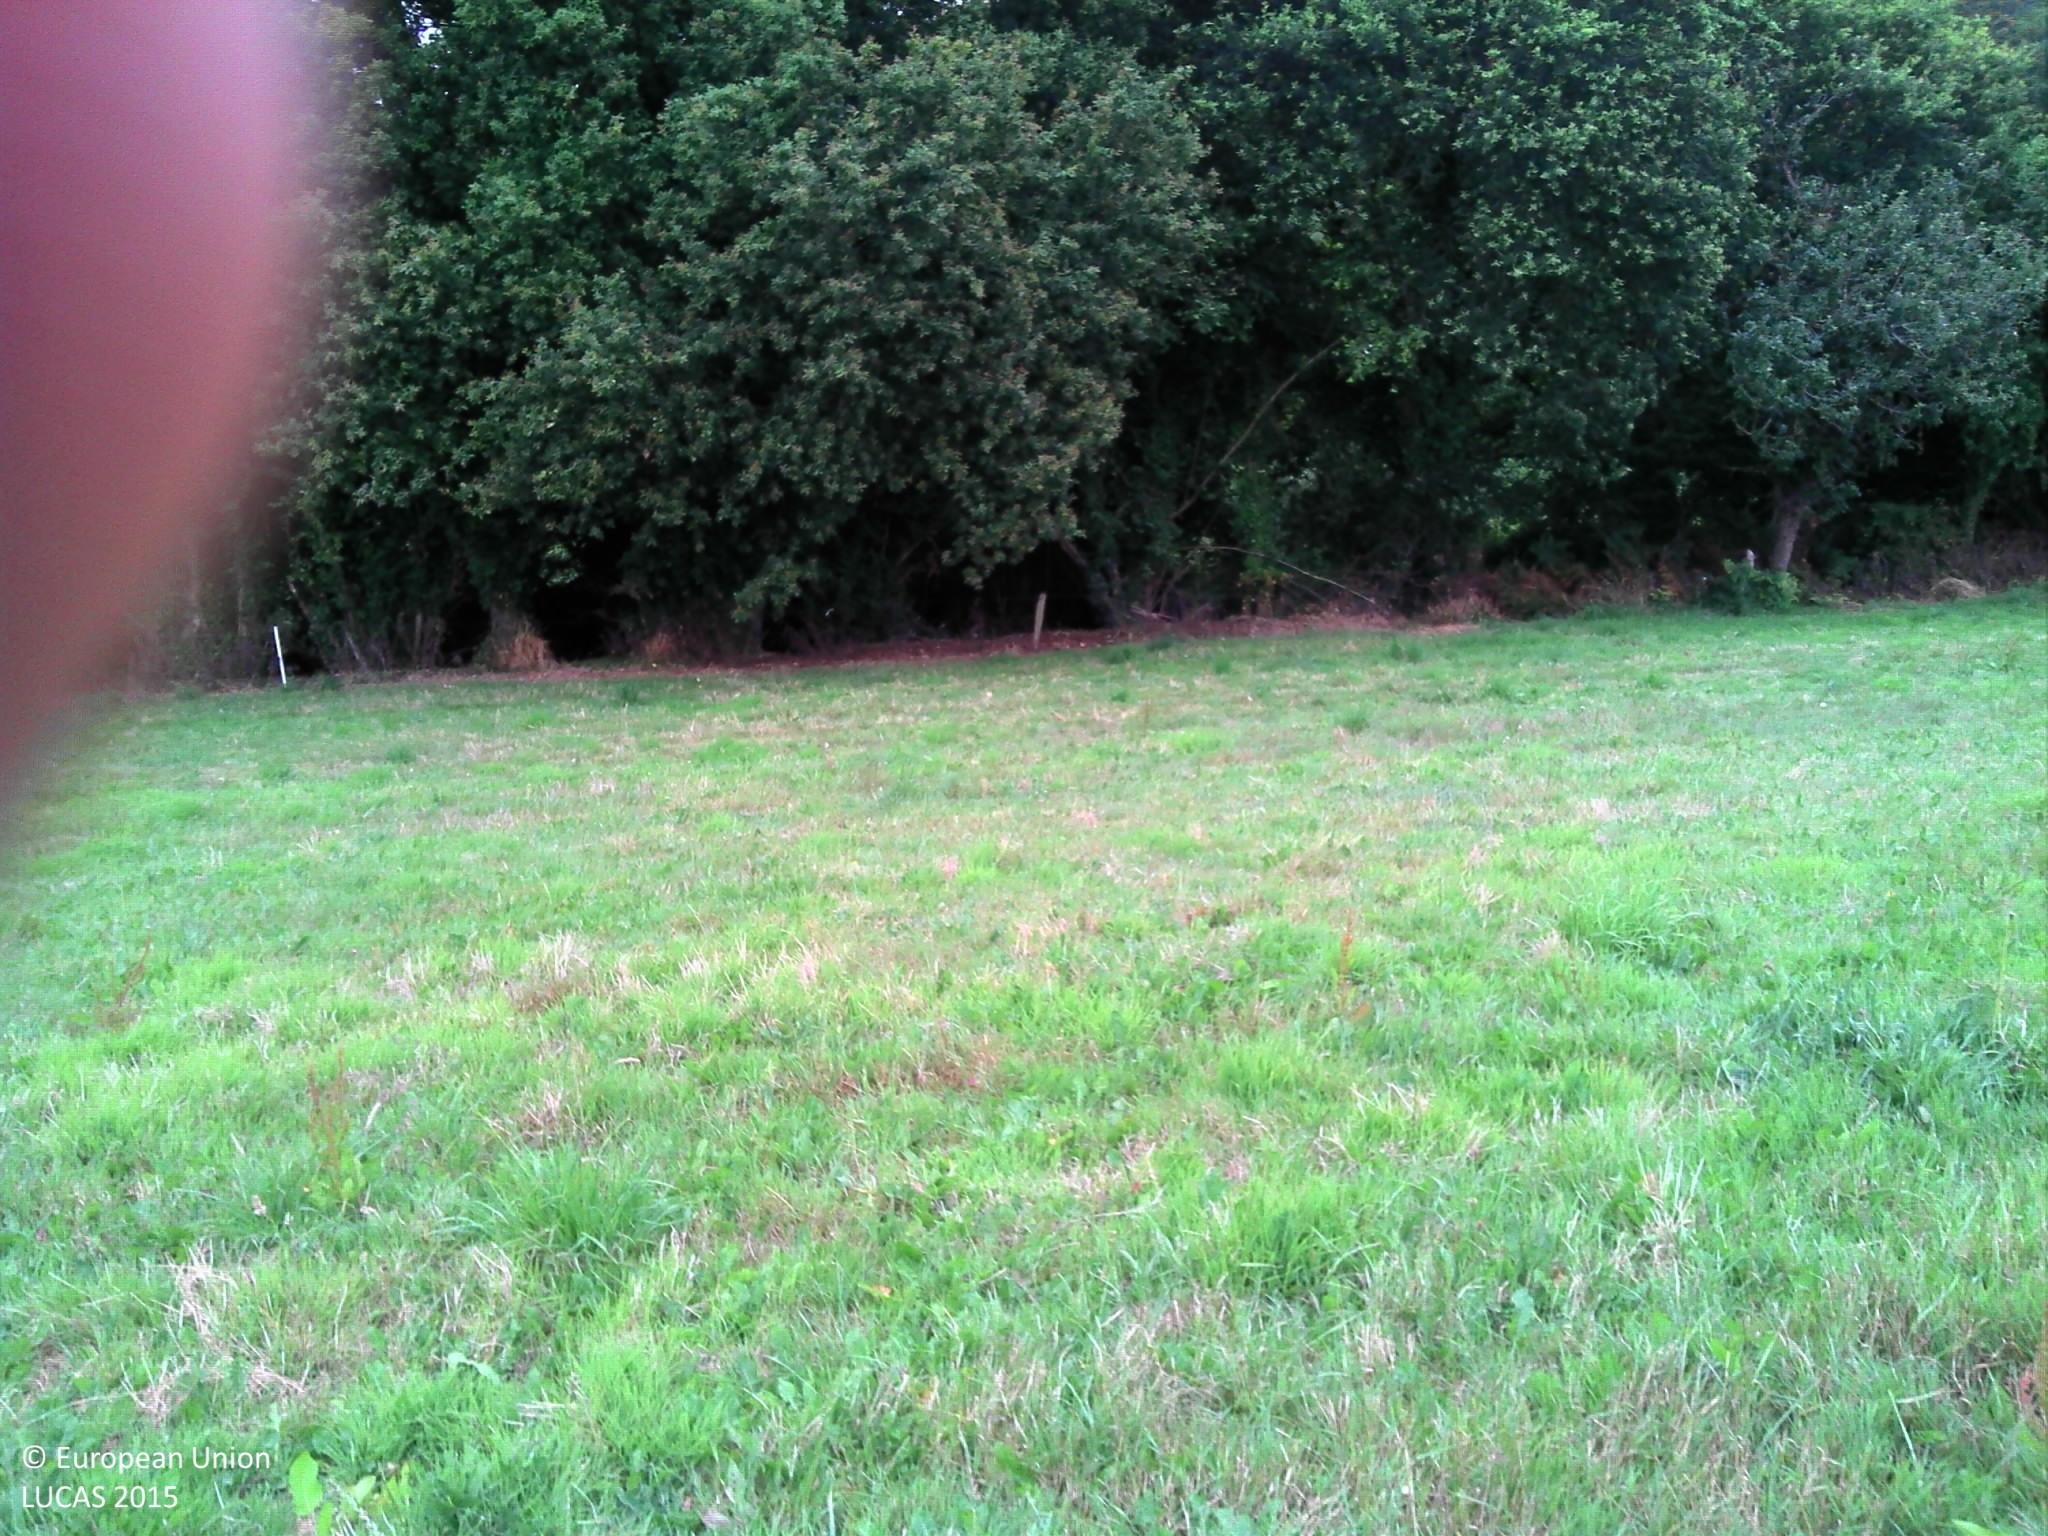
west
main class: Grassland
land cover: Grassland without tree/shrub cover
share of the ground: > 75 %
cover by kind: herbaceous plants 100 %
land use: Agriculture (excluding fallow land and kitchen gardens)
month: July
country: FR
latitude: 48.0987
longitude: -3.6559
